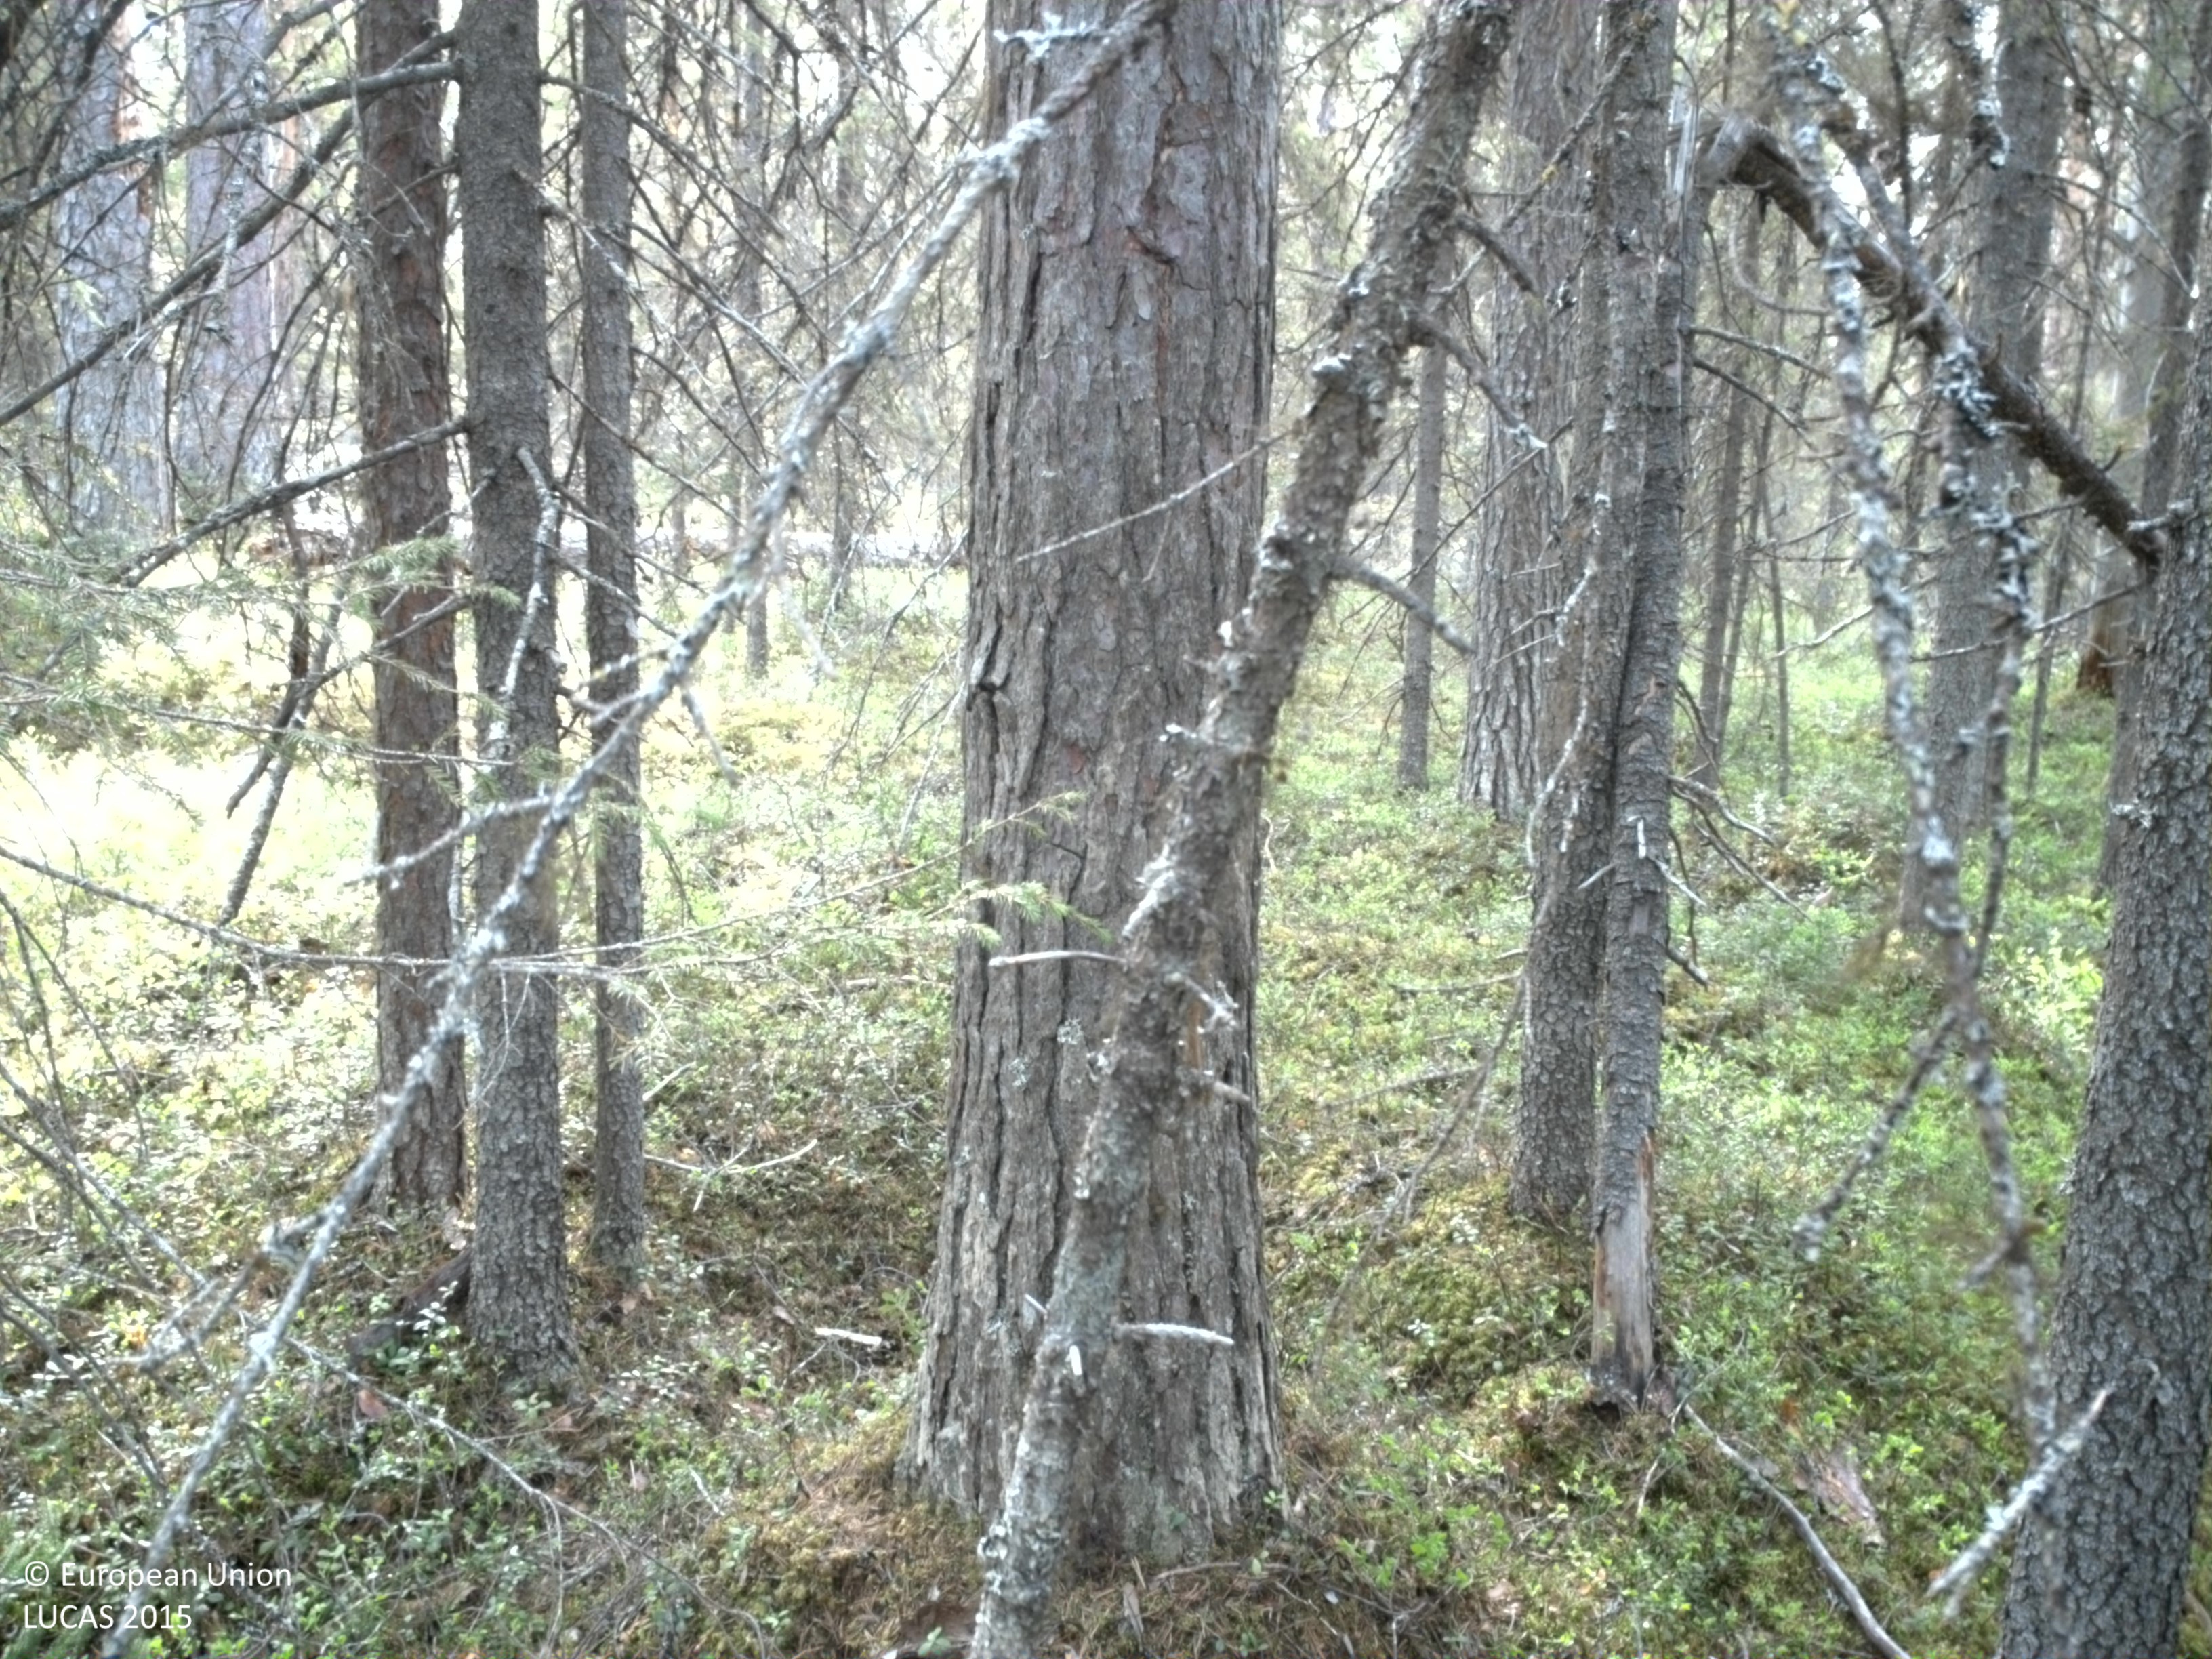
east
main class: Woodland
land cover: Other coniferous woodland
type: boreal forest
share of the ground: 50 - 75 %
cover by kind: coniferous forest trees 65 %, shrubs 35 %
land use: Amenities, museums, leisure
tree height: > 5 m
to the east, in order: Other coniferous woodland; Ditches and canals; Other coniferous woodland; Shrubland with sparse tree cover; Paved roads, cycling and walking lanes; Ditches and canals; Shrubland with sparse tree cover; Pine dominated coniferous woodland
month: June
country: SE
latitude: 65.7588
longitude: 19.7175
